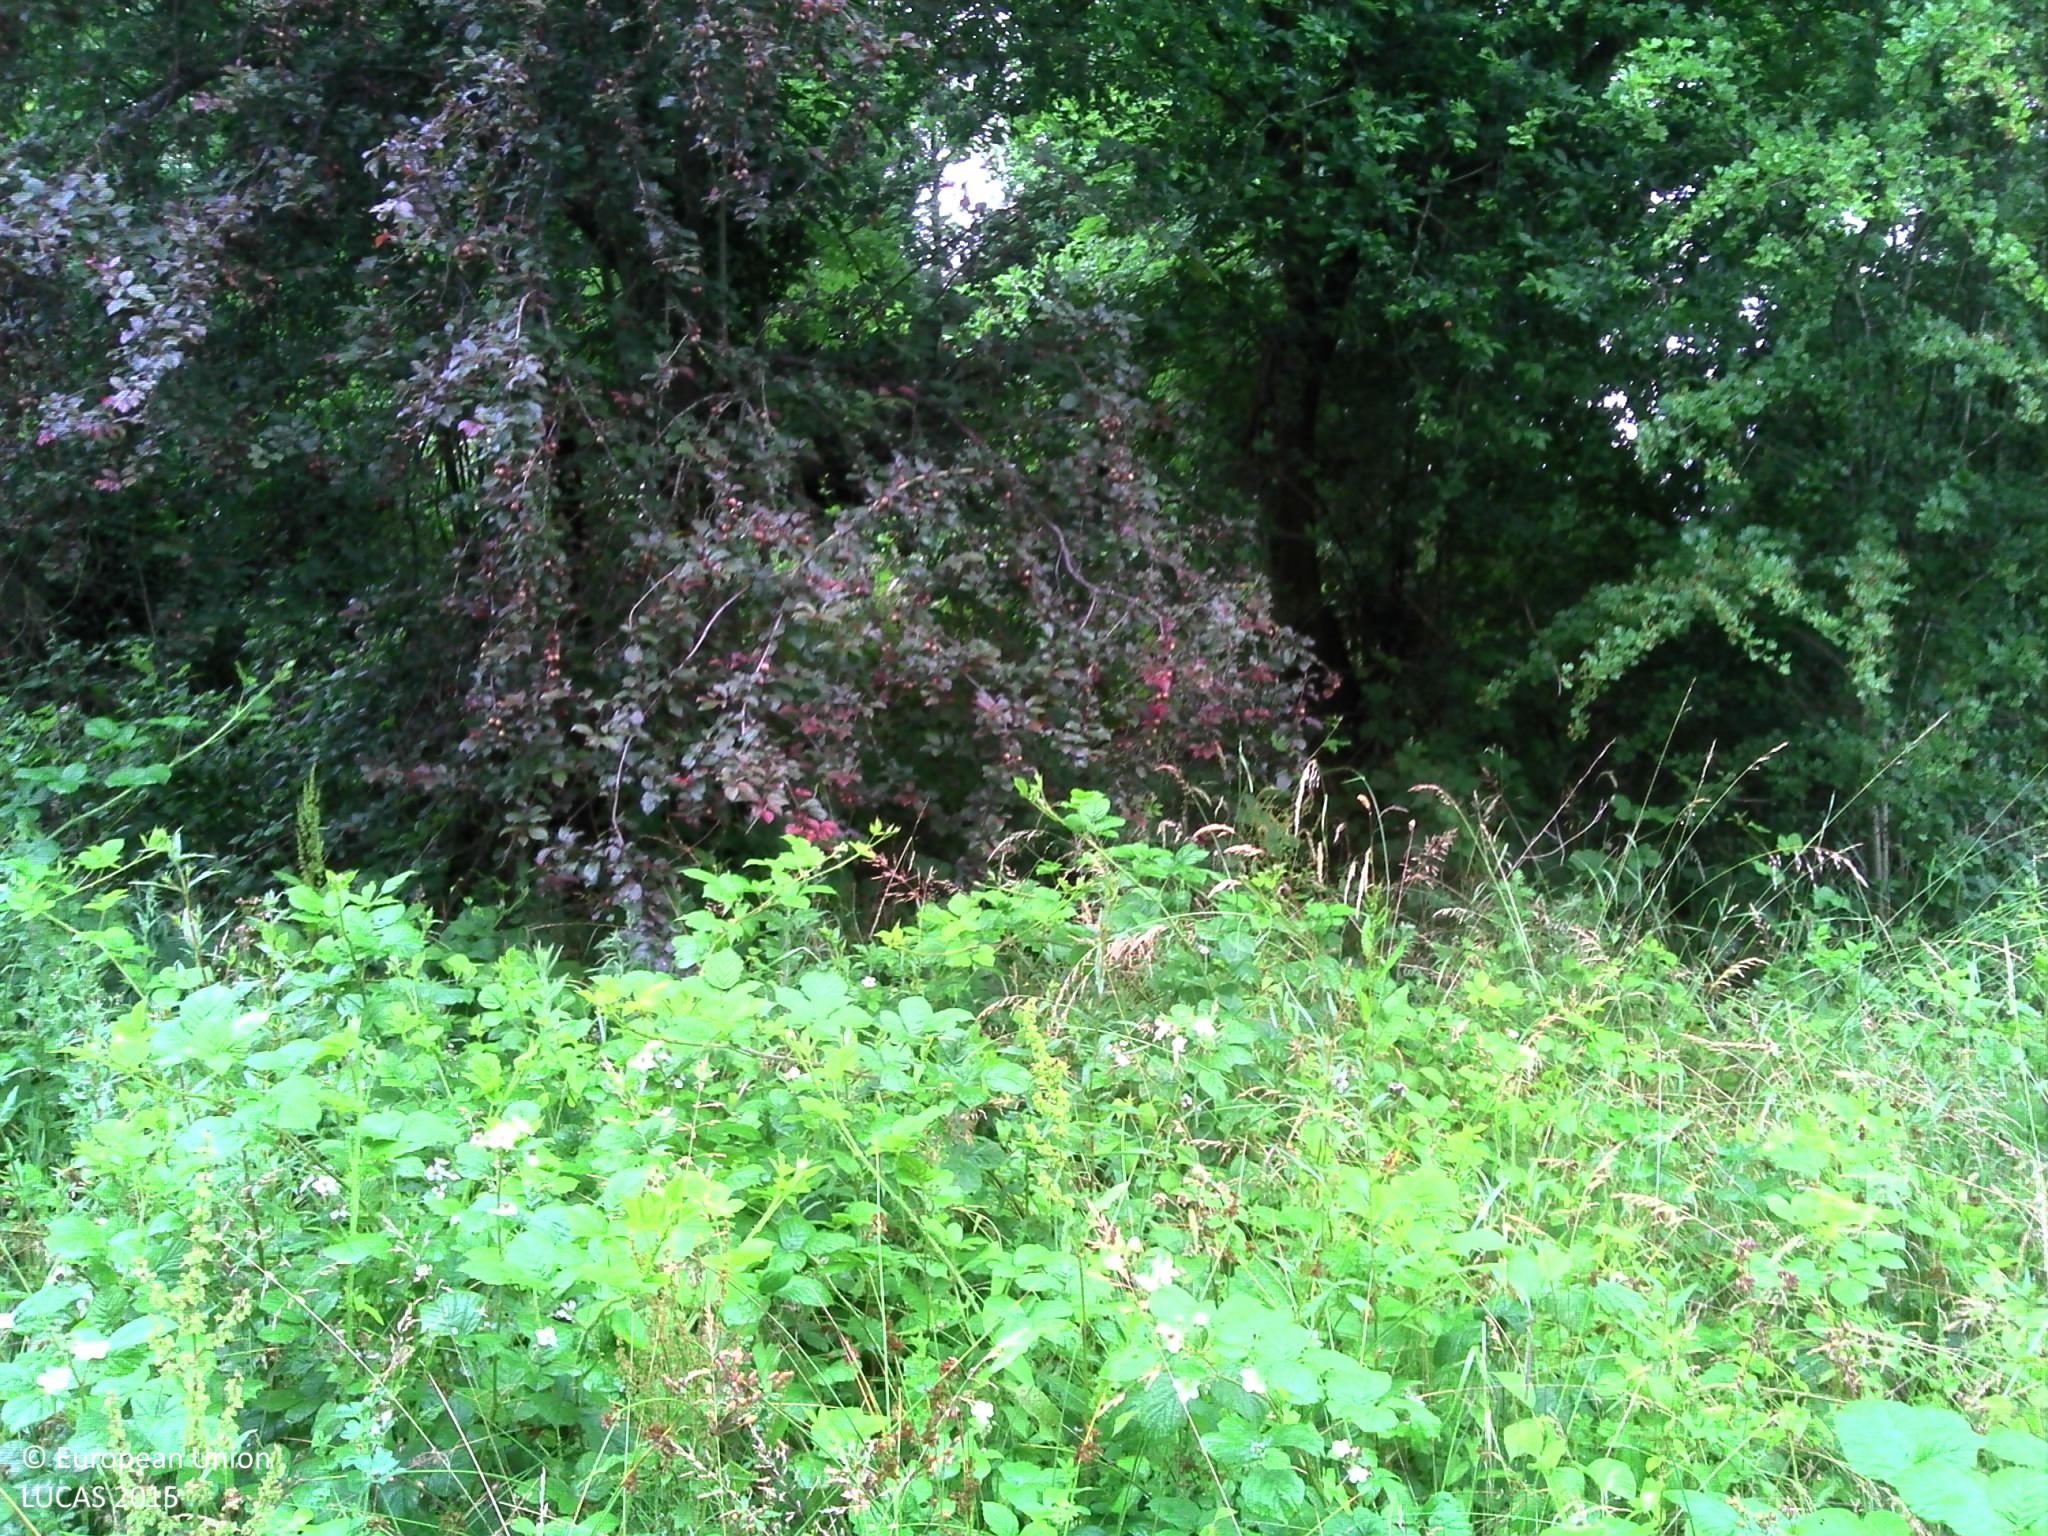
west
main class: Shrubland
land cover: Shrubland without tree cover
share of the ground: > 75 %
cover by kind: shrubs 90 %, herbaceous plants 10 %
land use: Semi-natural and natural areas not in use
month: June
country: FR
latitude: 48.6458
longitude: 6.2405
